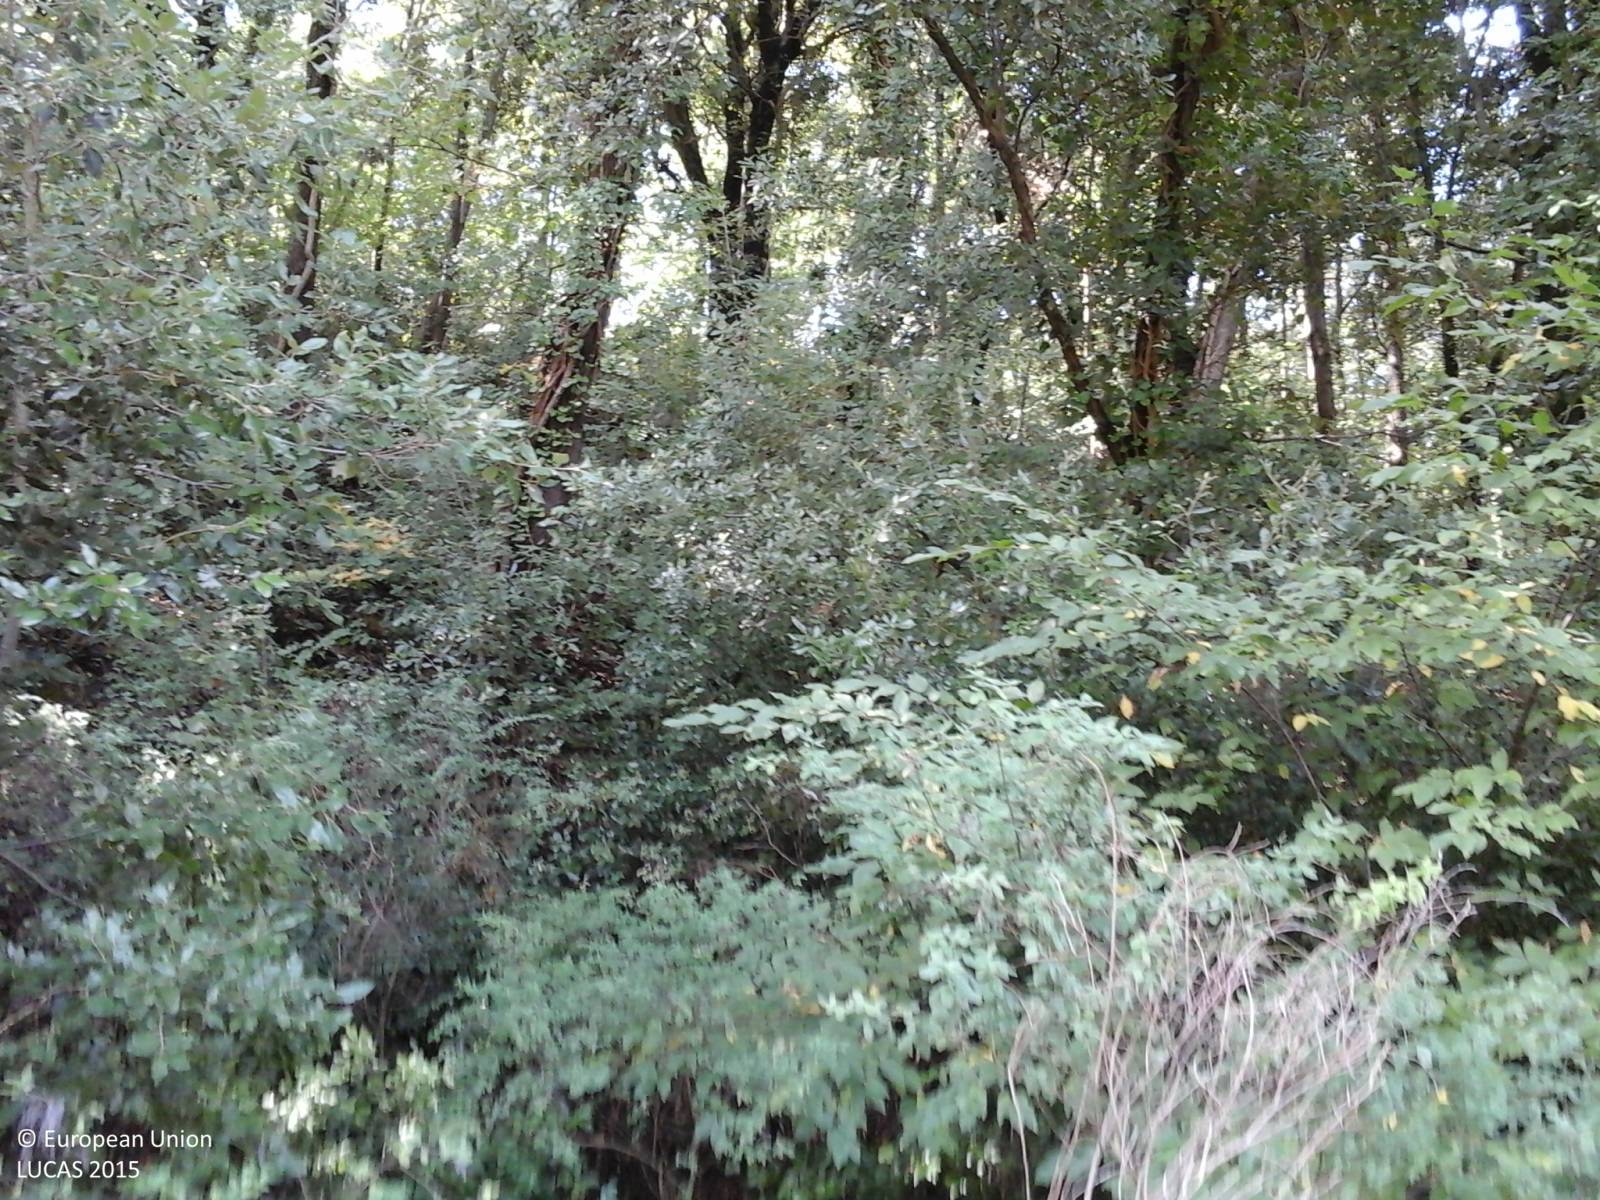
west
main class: Woodland
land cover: Broadleaved woodland
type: thermophilous deciduous forest
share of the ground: > 75 %
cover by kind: broadleaved forest trees 85 %, shrubs 15 %
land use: Forestry
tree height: > 5 m
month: October
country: IT
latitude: 43.0293
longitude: 10.8931
